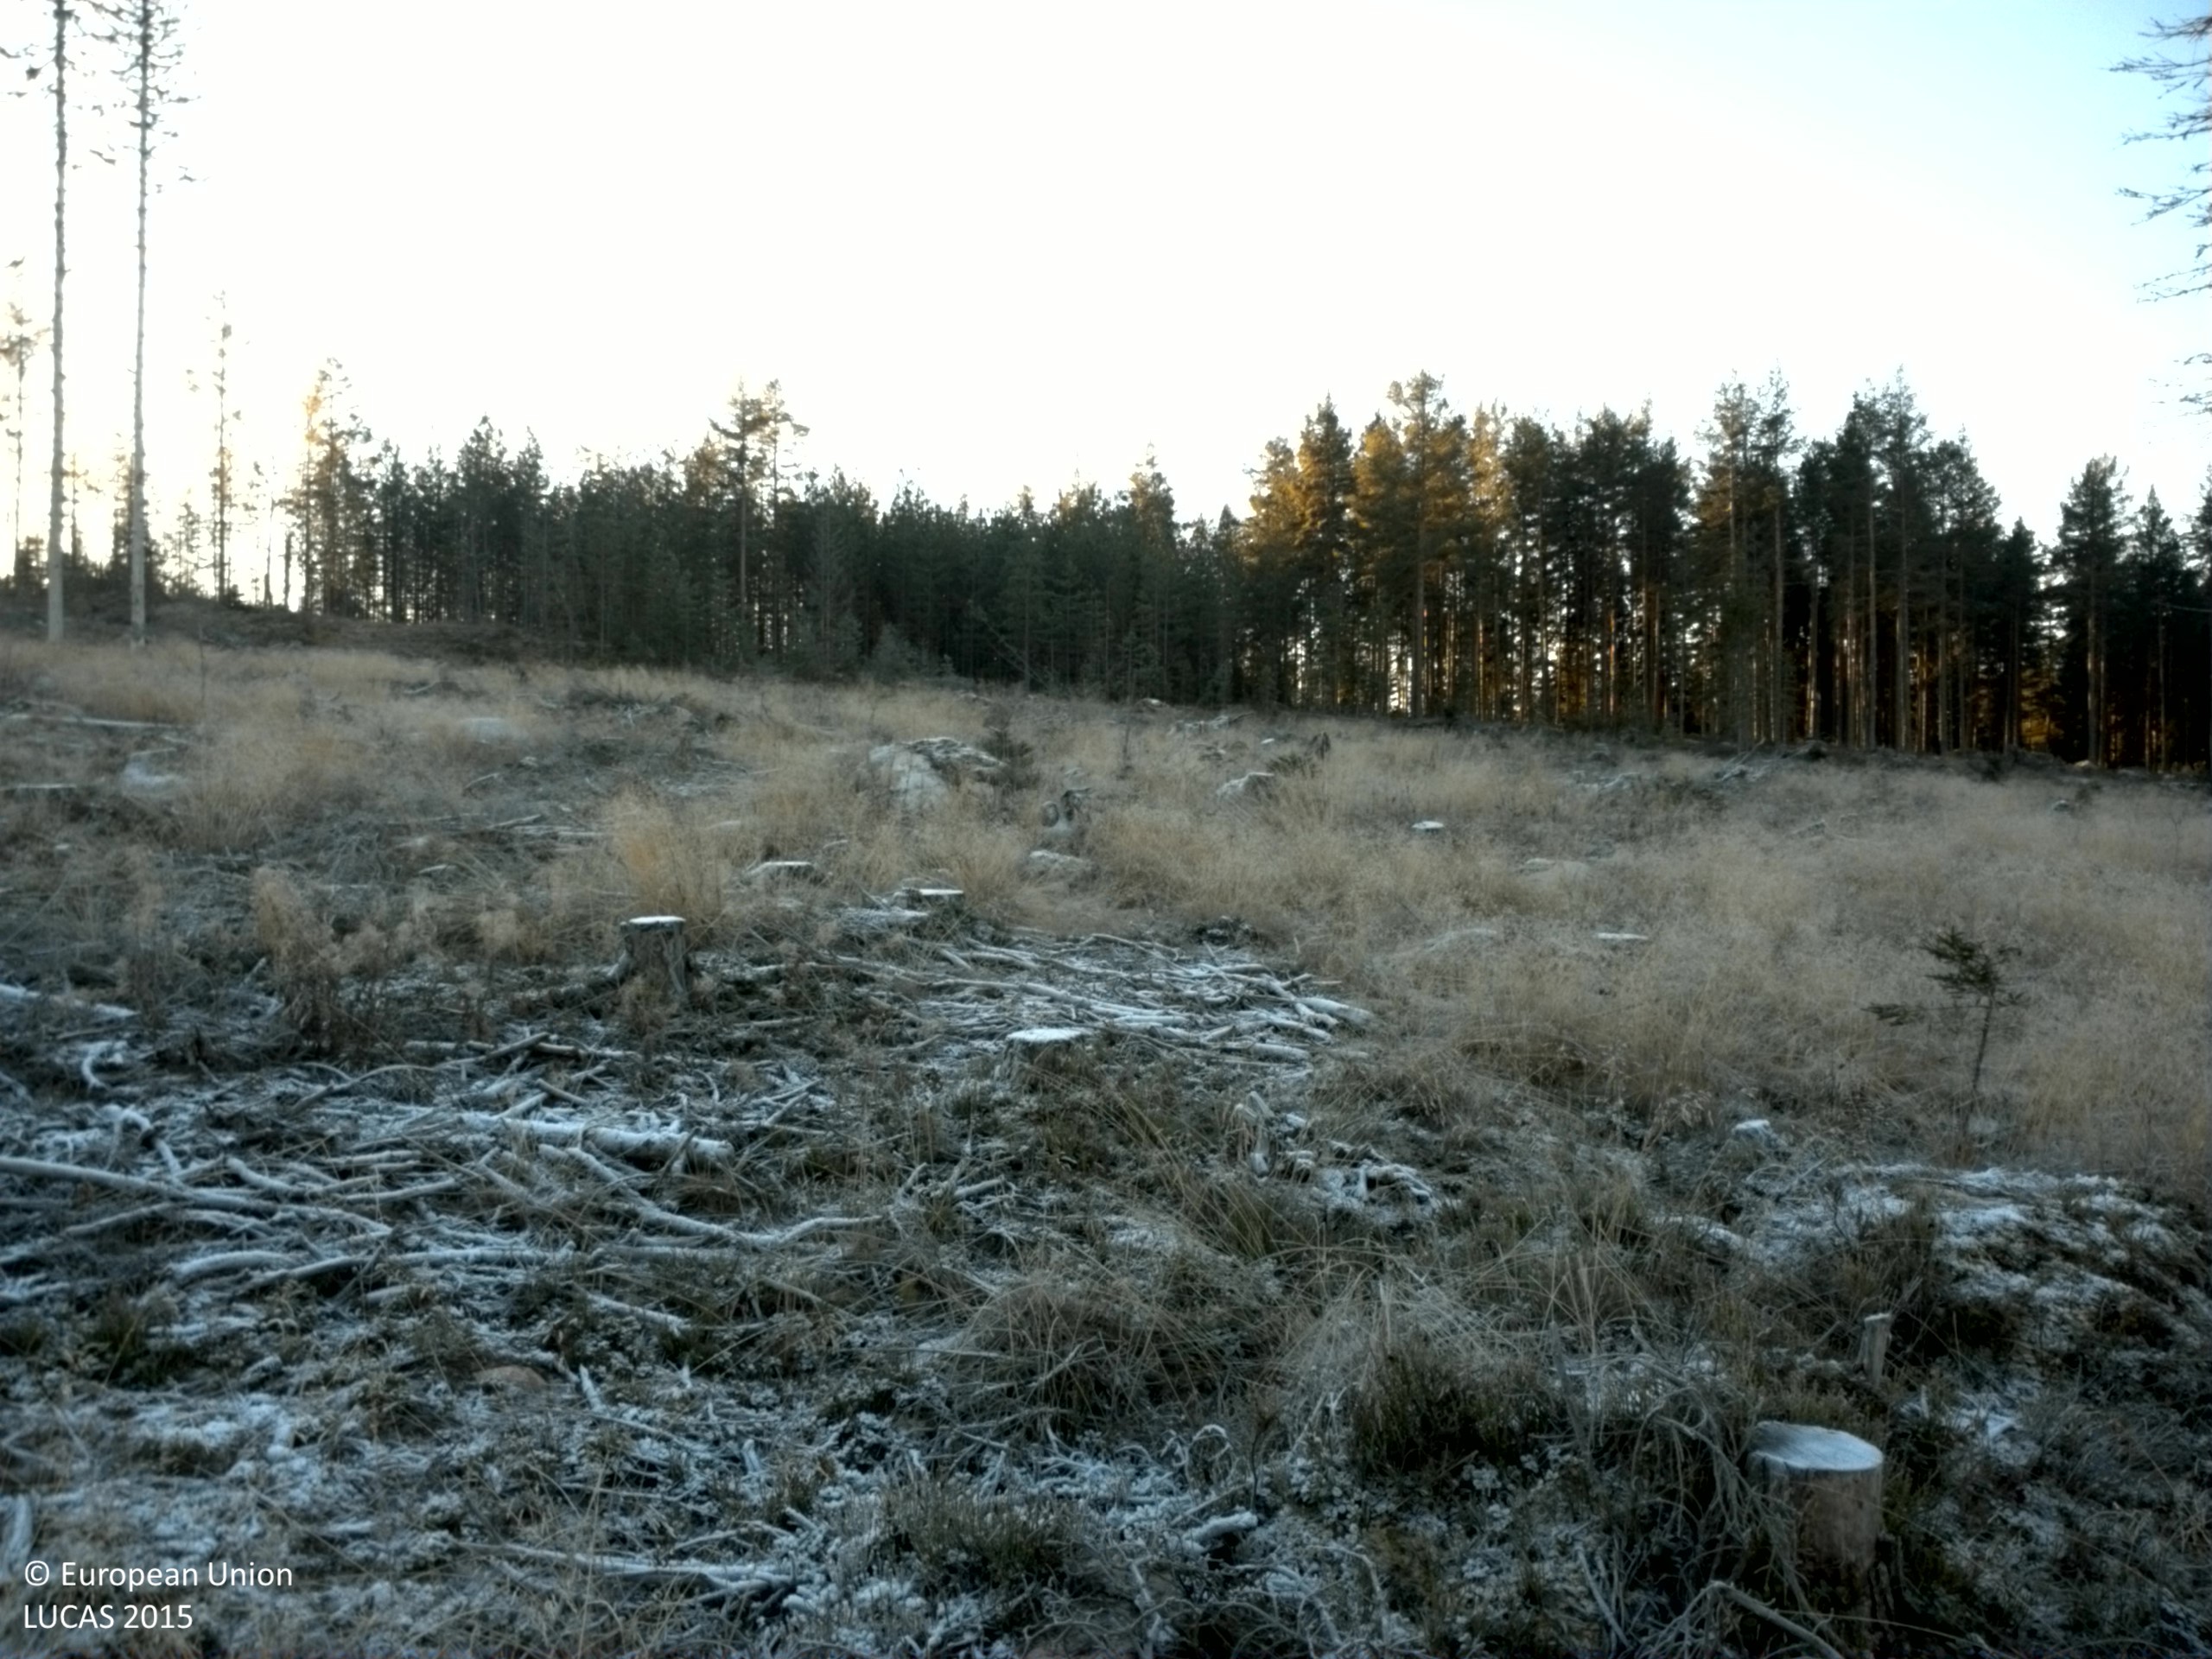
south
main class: Shrubland
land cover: Shrubland with sparse tree cover
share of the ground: 25 - 50 %
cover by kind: shrubs 35 %, lichens and mosses 30 %, herbaceous plants 20 %, coniferous forest trees 5 %, consolidated bare surface 5 %, unconsolidated bare surface 5 %
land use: Forestry
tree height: < 5 m
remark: Clear cut
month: November
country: SE
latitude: 61.7832
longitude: 16.1064
